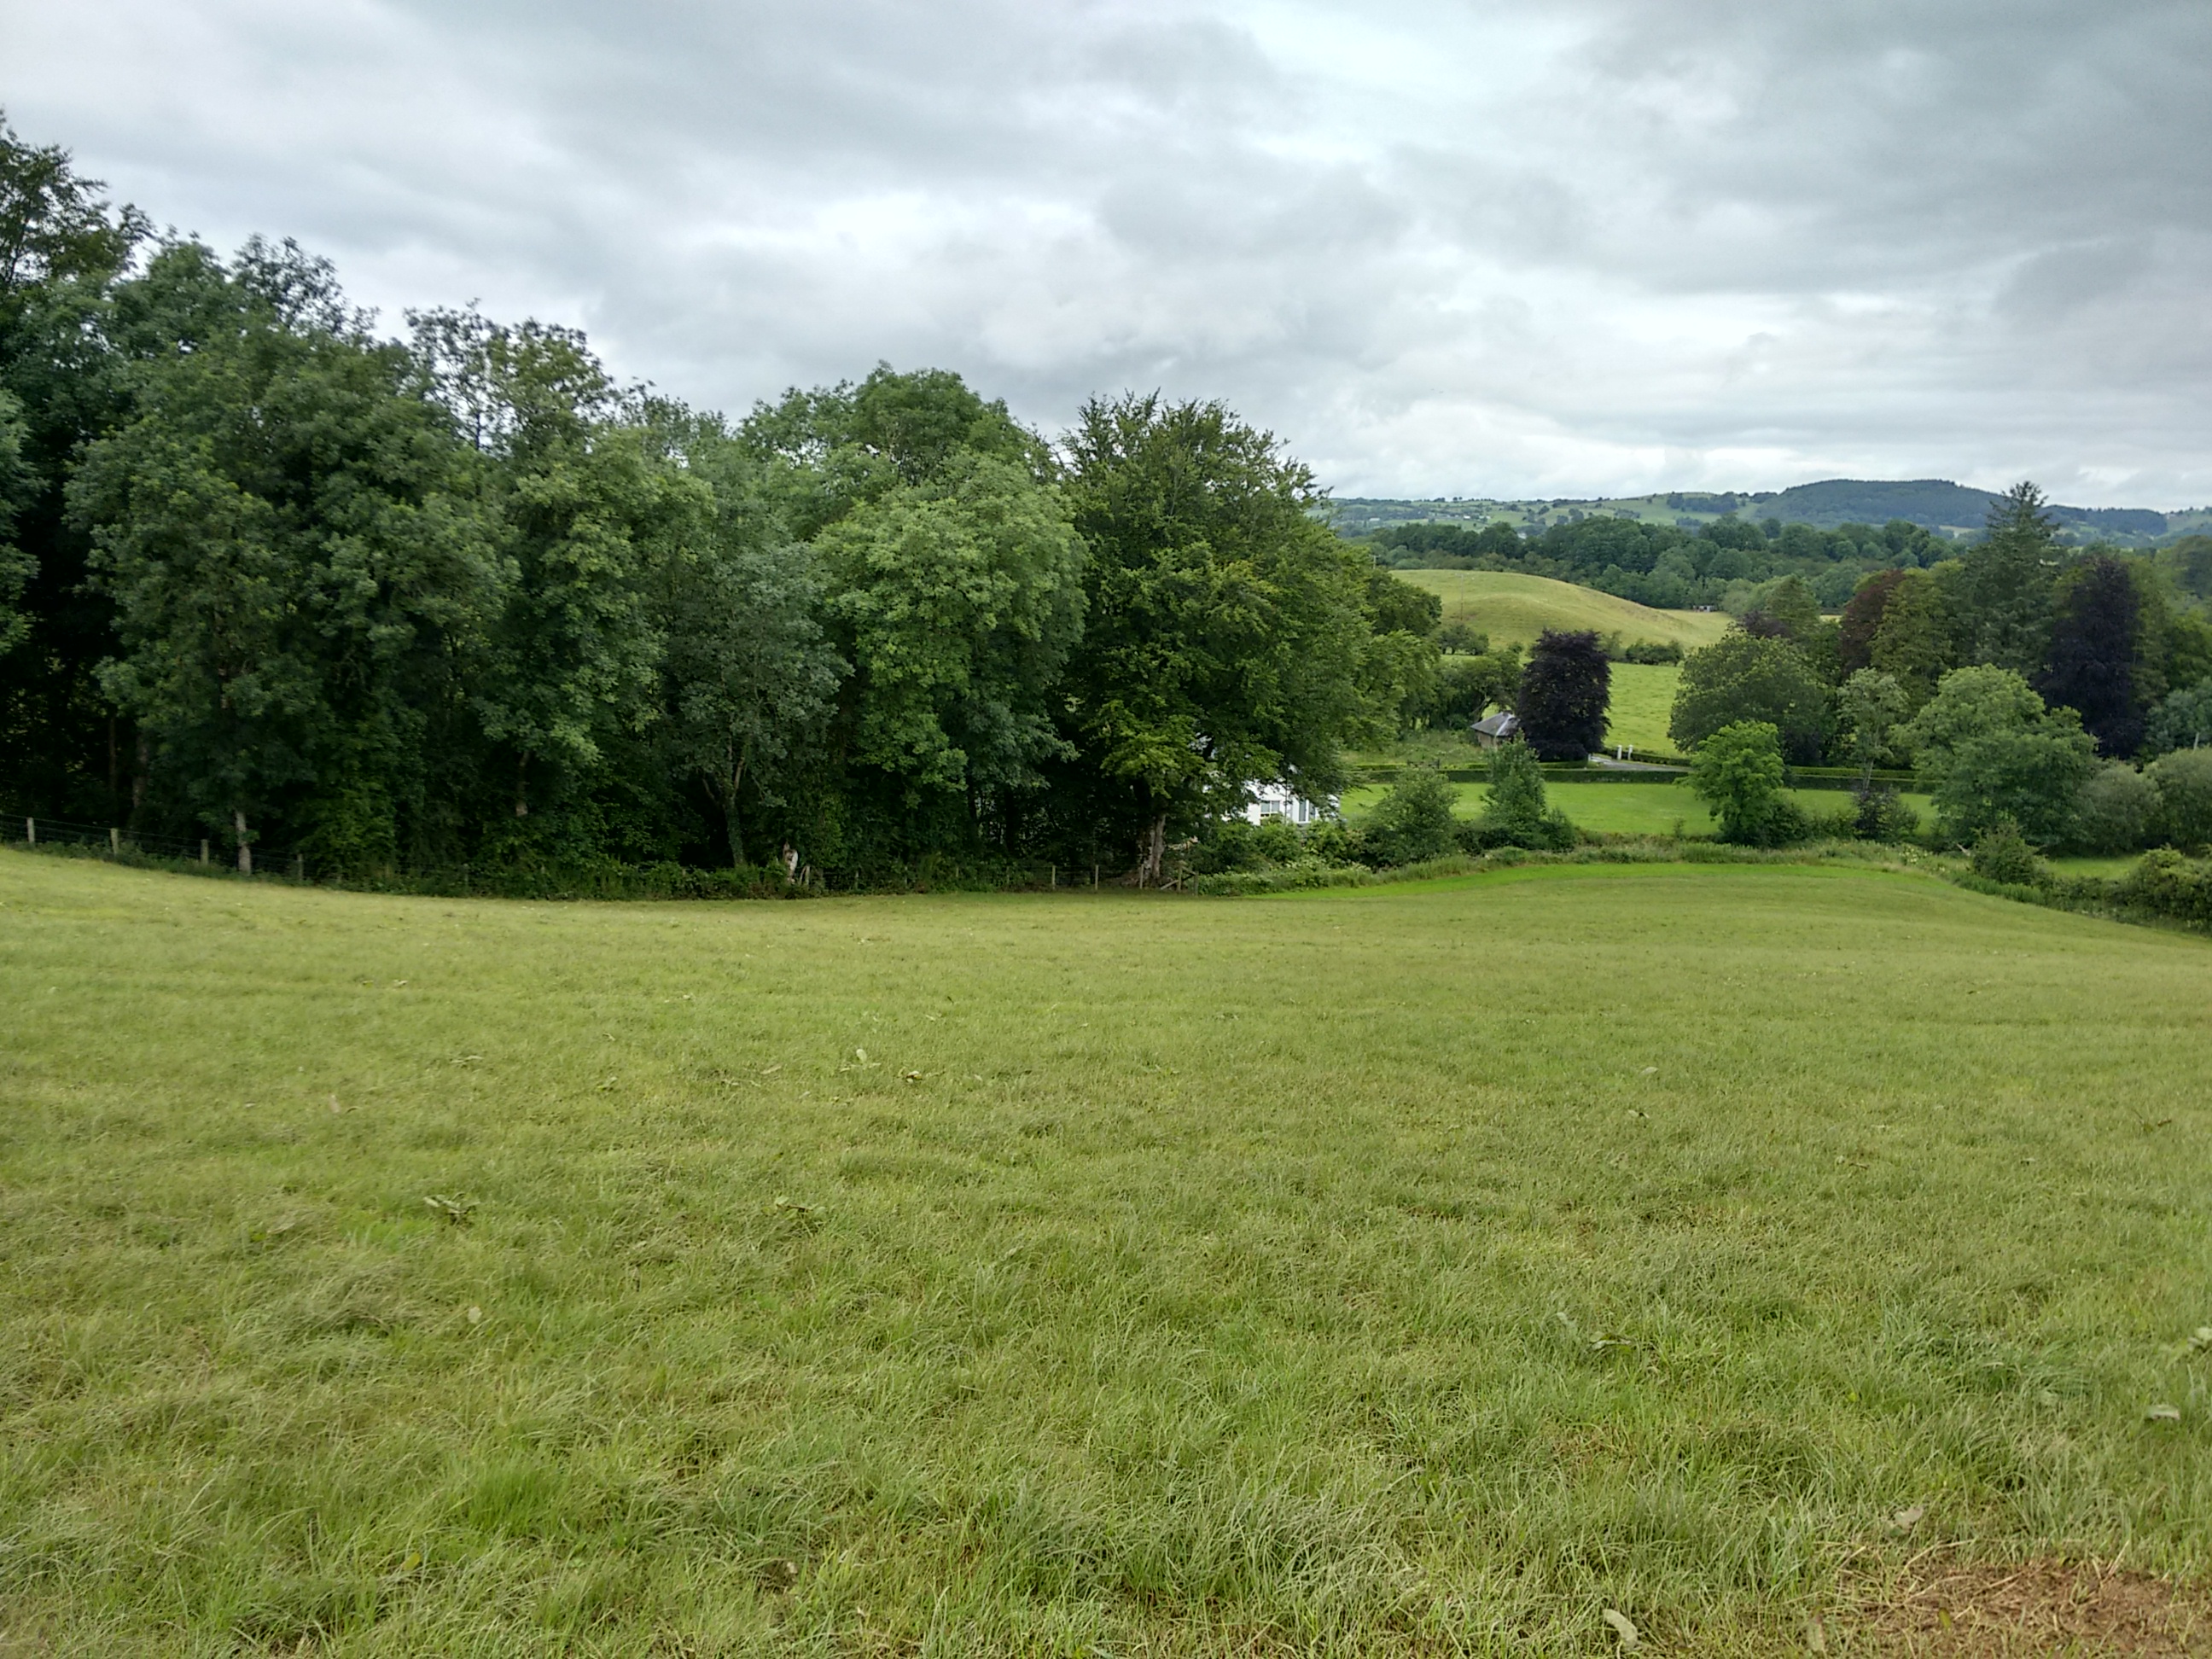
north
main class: Grassland
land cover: Grassland without tree/shrub cover
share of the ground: > 75 %
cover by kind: herbaceous plants 100 %
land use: Agriculture (excluding fallow land and kitchen gardens)
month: July
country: GB
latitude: 54.4044
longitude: -7.2000
